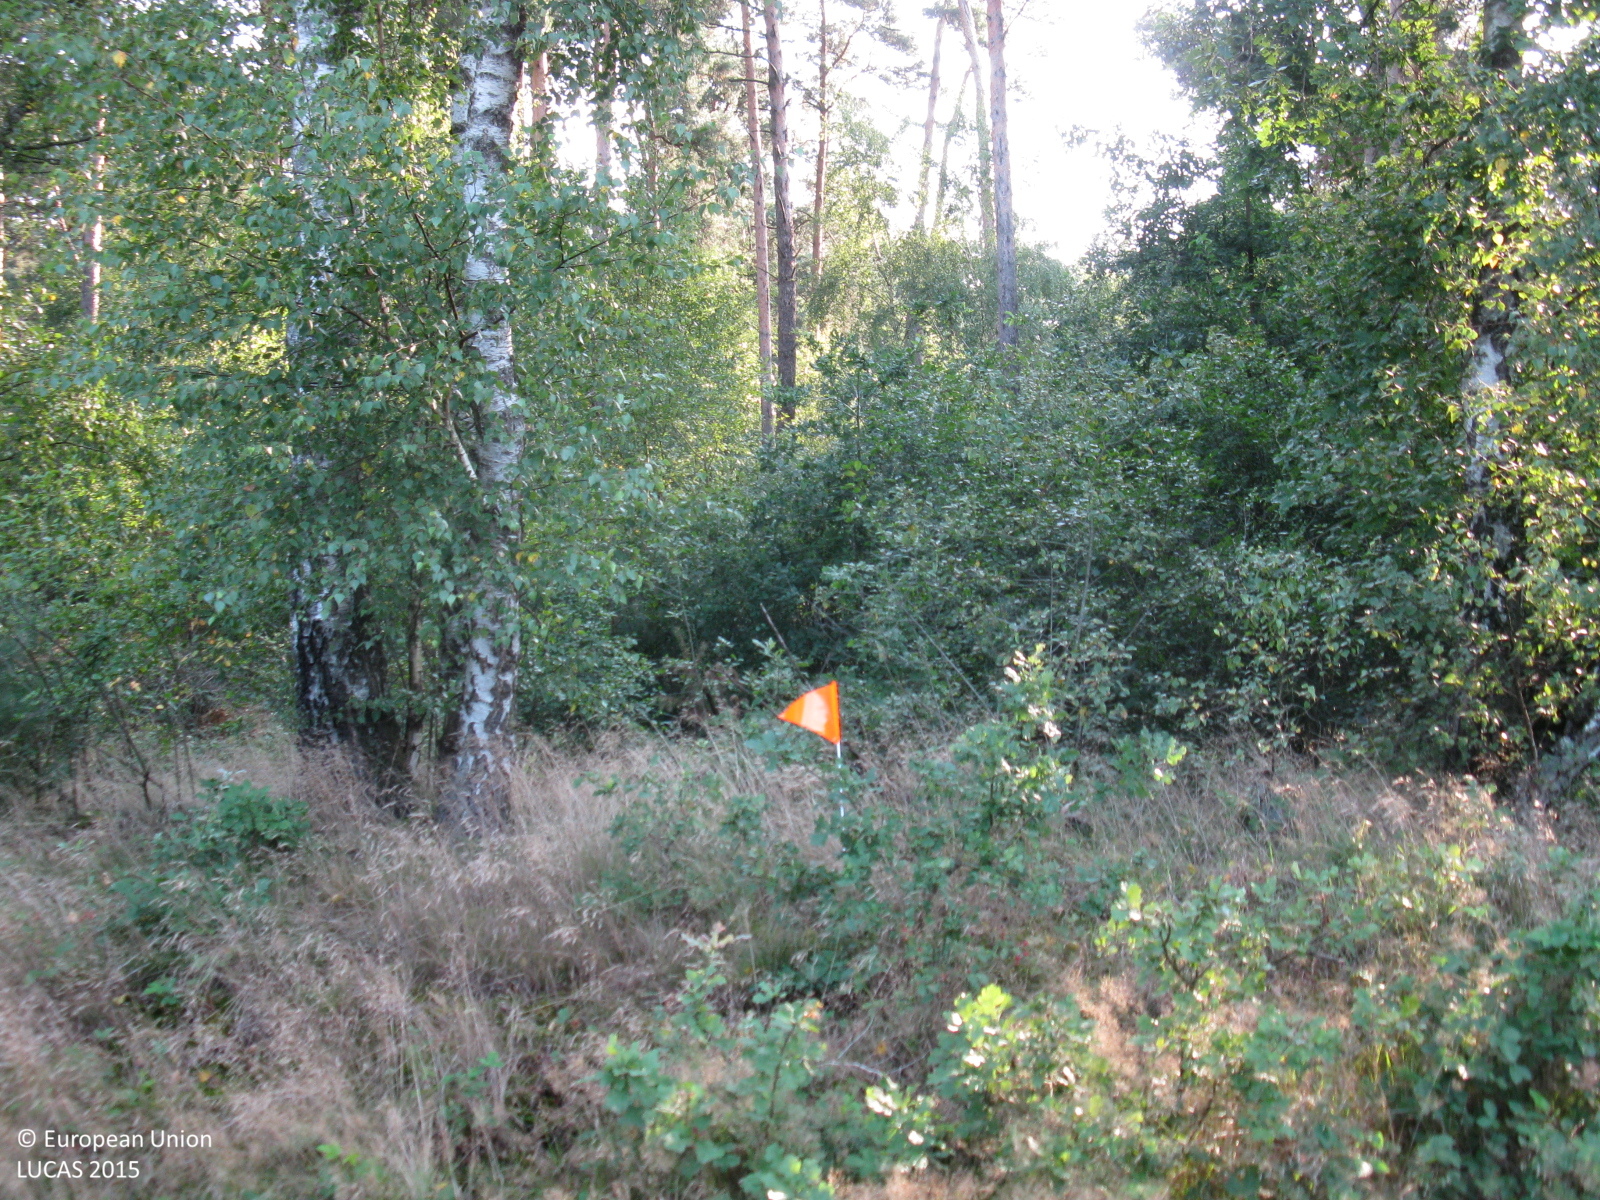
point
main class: Woodland
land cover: Pine dominated mixed woodland
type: hemiboreal forest and nemoral coniferous forest and mixed broadleaved-coniferous forest
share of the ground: > 75 %
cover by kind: coniferous forest trees 50 %, broadleaved forest trees 50 %
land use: Forestry
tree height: > 5 m
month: August
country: DE
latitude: 51.8523
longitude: 6.9367
